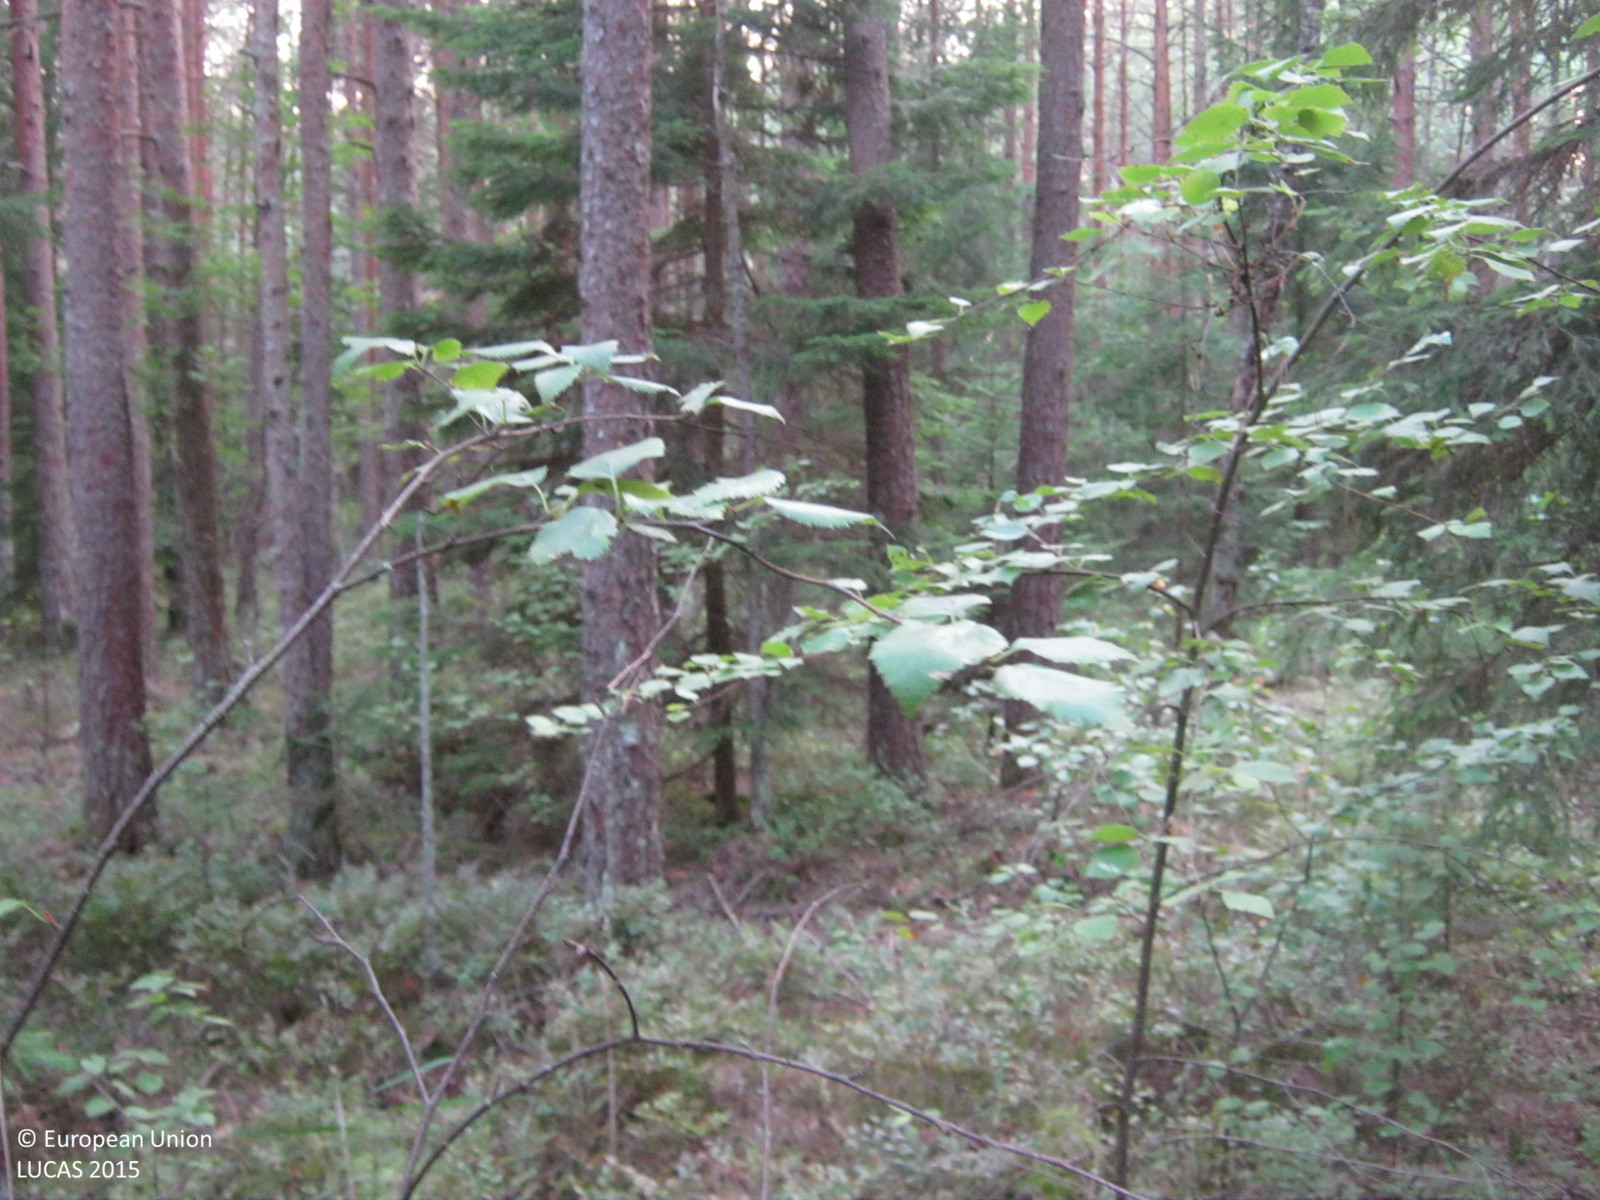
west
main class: Woodland
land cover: Pine dominated coniferous woodland
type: hemiboreal forest and nemoral coniferous forest and mixed broadleaved-coniferous forest
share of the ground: > 75 %
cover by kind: coniferous forest trees 75 %, lichens and mosses 10 %, broadleaved forest trees 5 %, shrubs 5 %, herbaceous plants 5 %
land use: Forestry
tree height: > 5 m
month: August
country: LV
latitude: 57.4340
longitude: 24.6021
